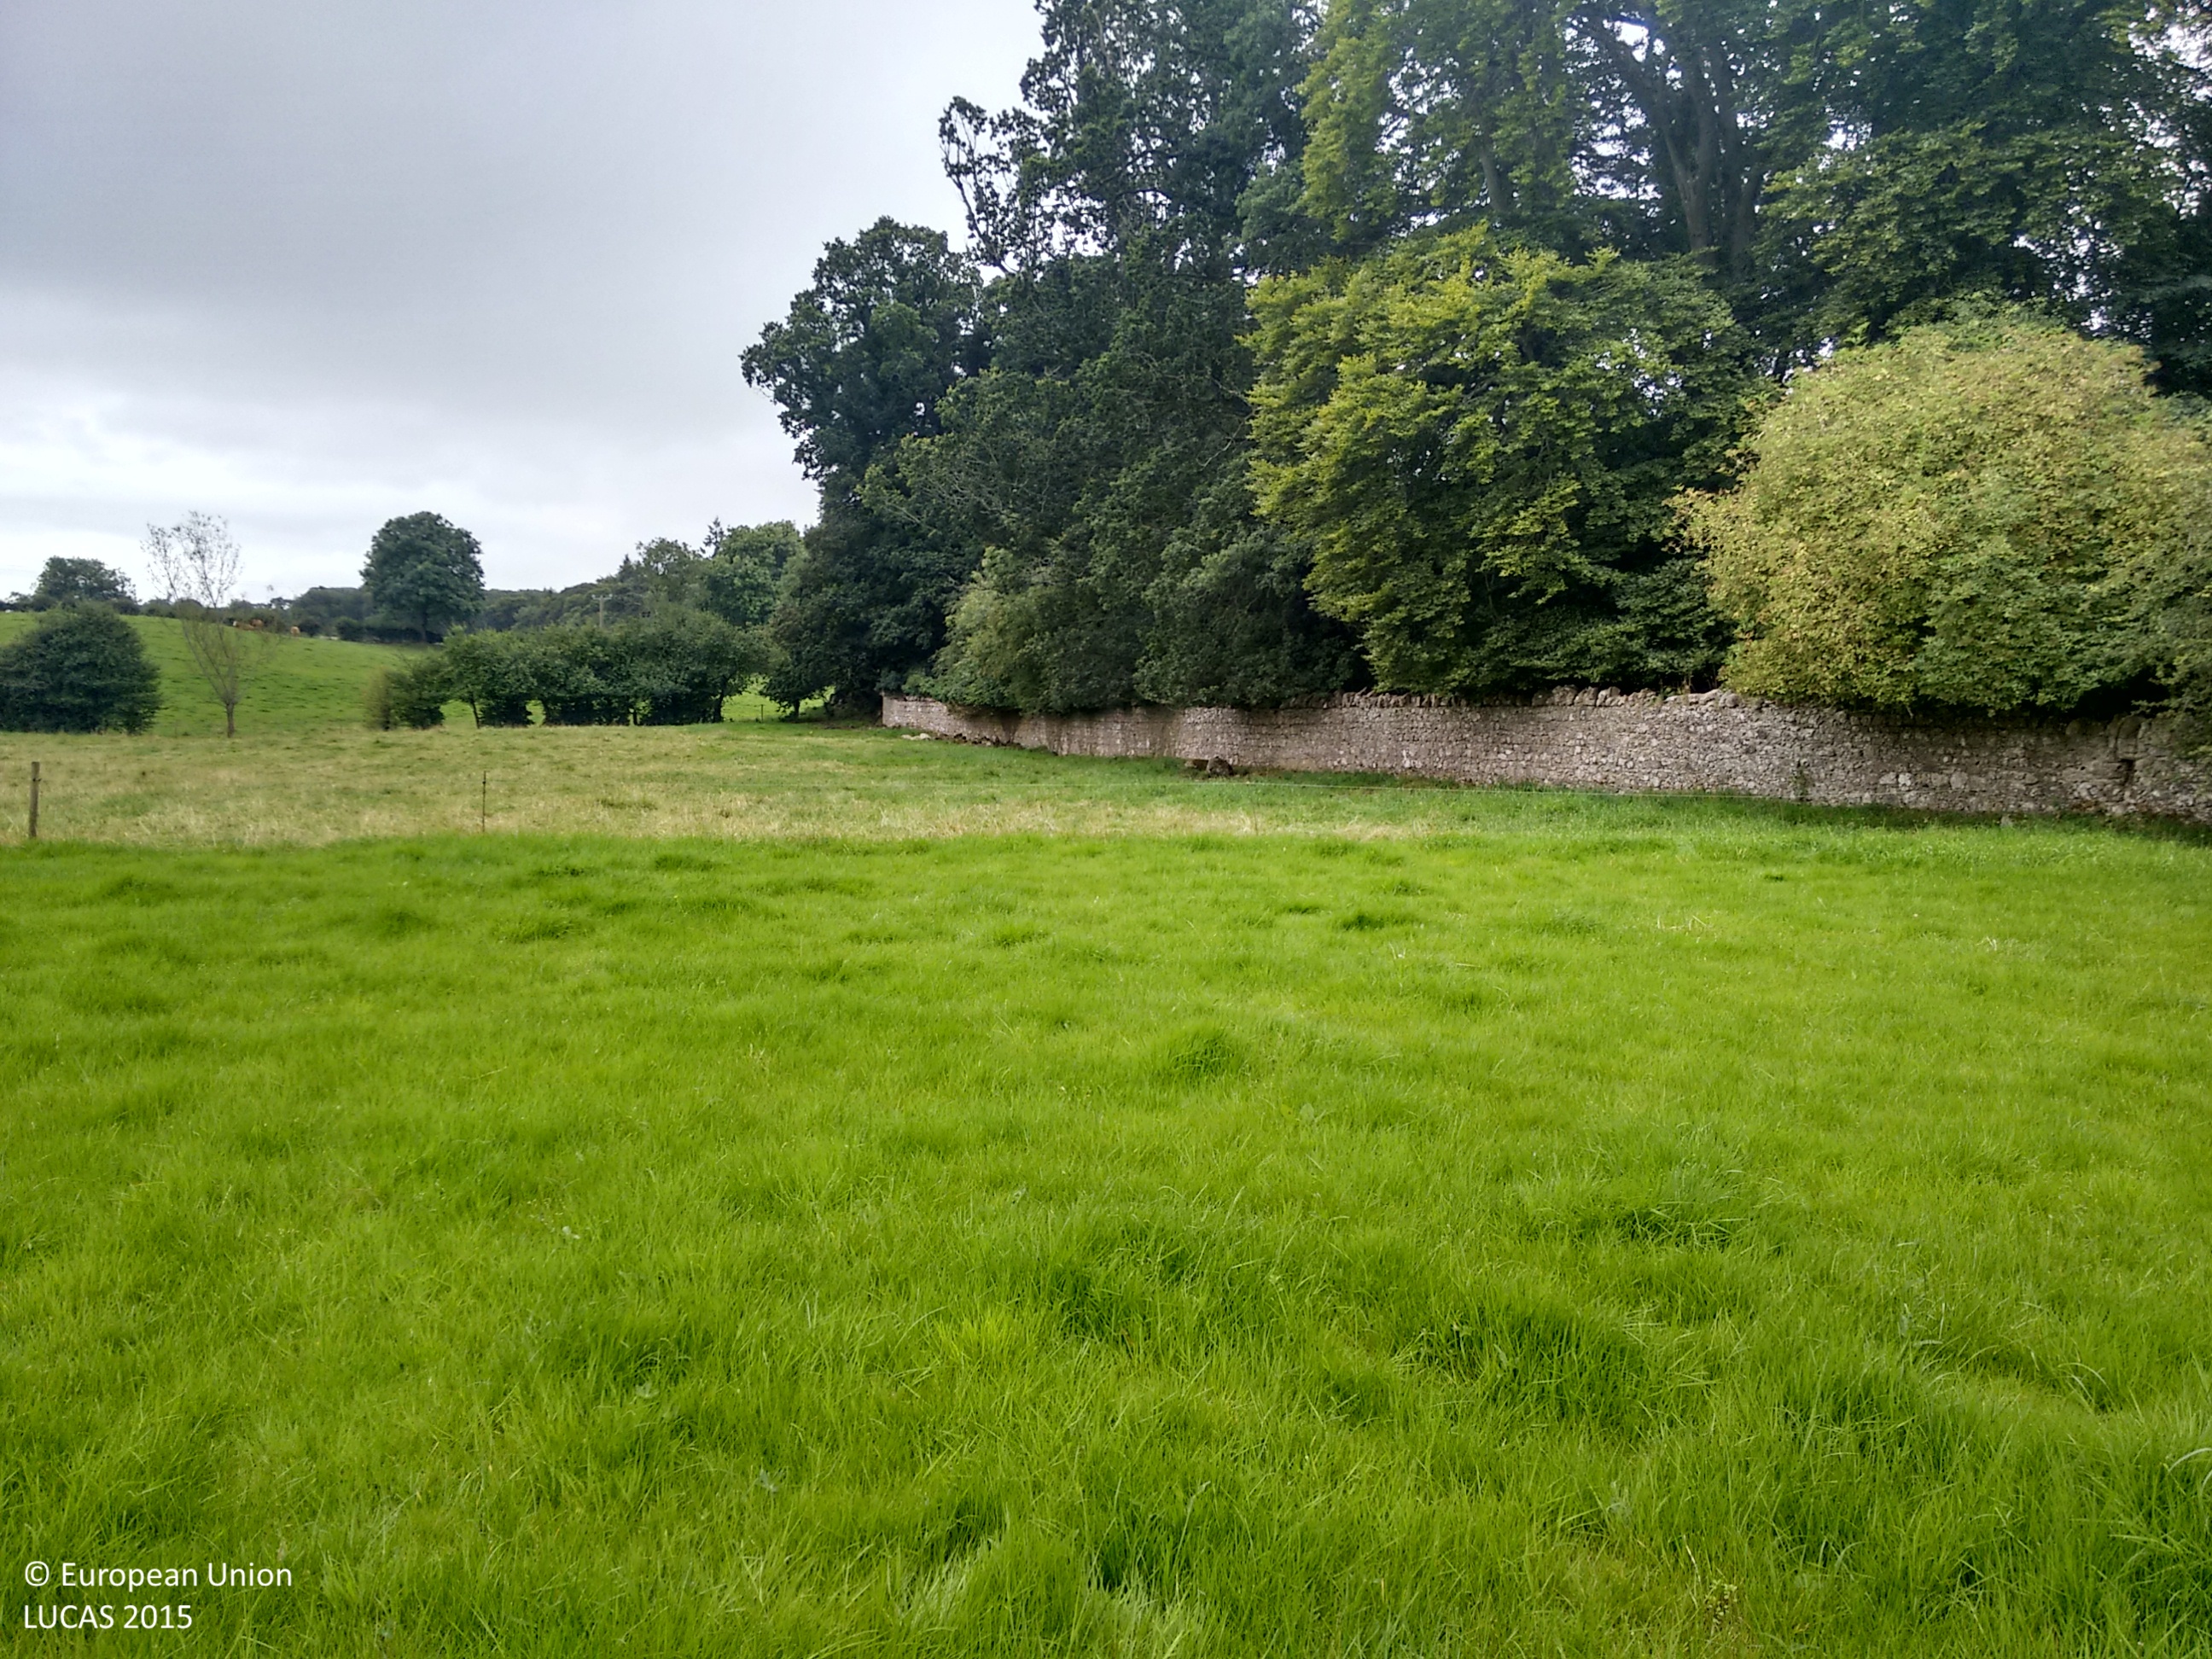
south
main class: Grassland
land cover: Grassland without tree/shrub cover
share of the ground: > 75 %
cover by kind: herbaceous plants 100 %
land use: Agriculture (excluding fallow land and kitchen gardens)
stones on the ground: < 10 %
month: August
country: IE
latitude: 53.9723
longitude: -6.7351
